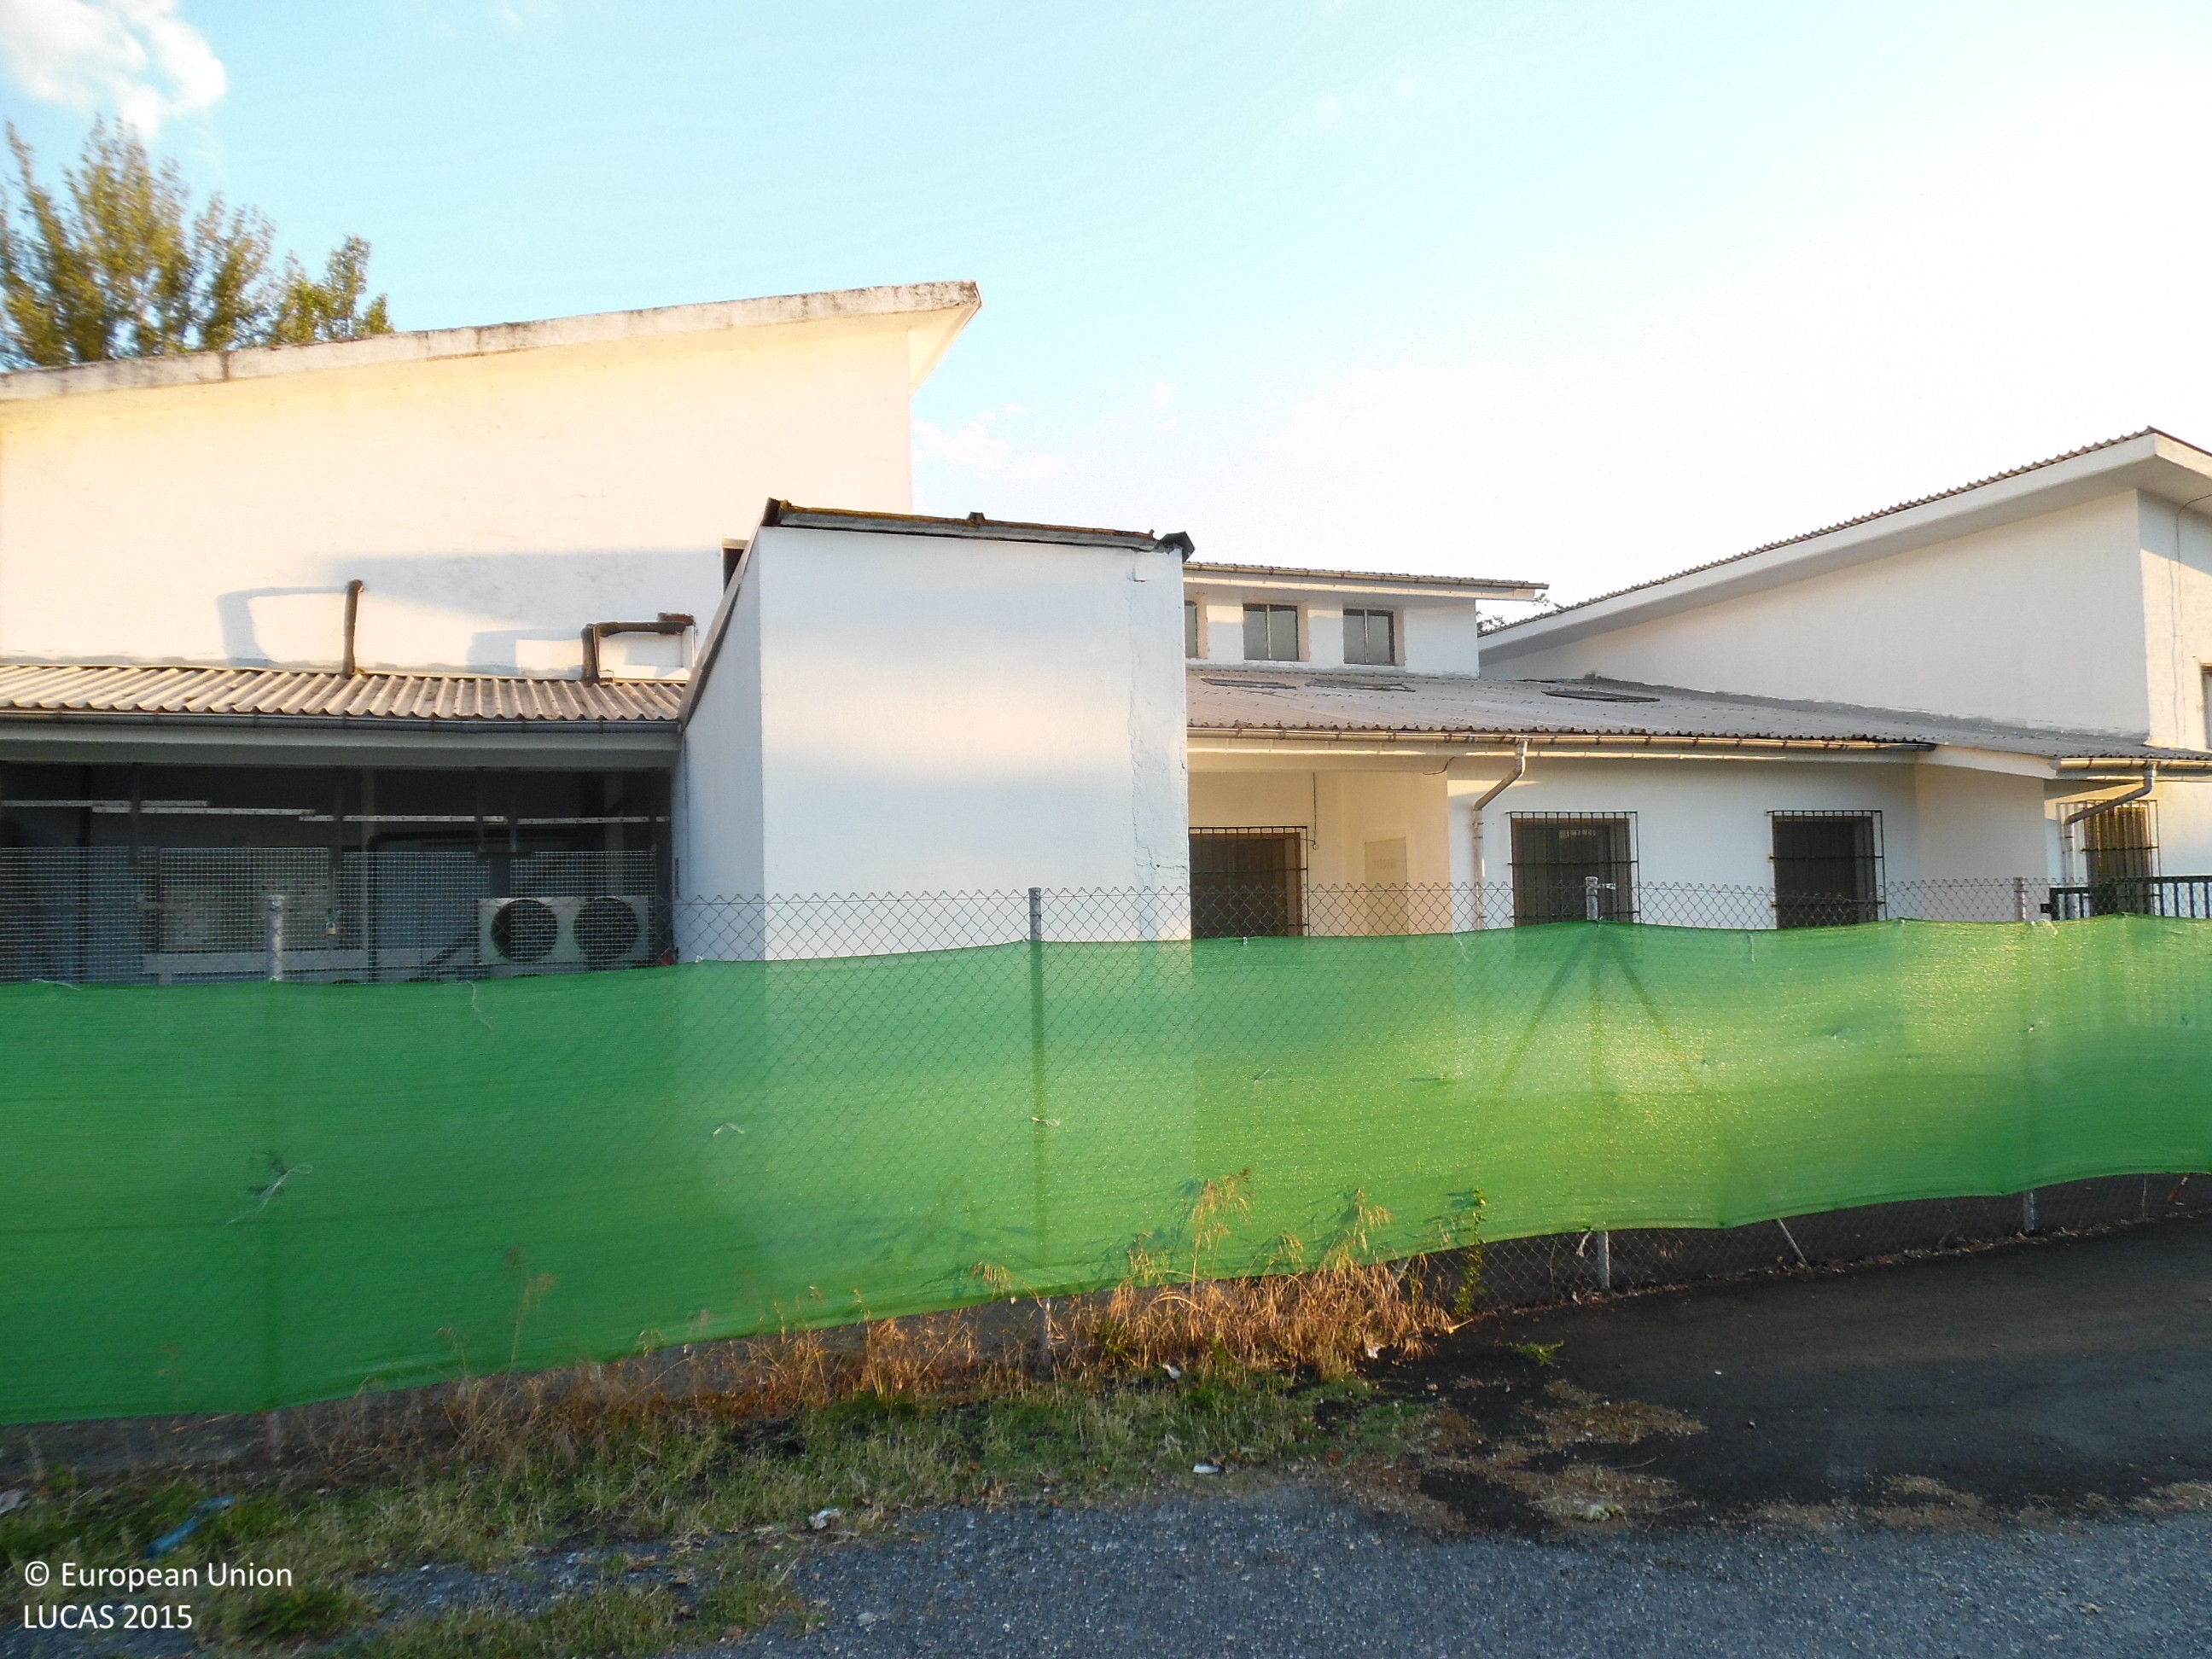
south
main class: Grassland
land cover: Grassland without tree/shrub cover
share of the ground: > 75 %
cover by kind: herbaceous plants 95 %, shrubs 5 %
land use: Agriculture (excluding fallow land and kitchen gardens)
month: June
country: ES
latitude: 42.6099
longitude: -6.4139
